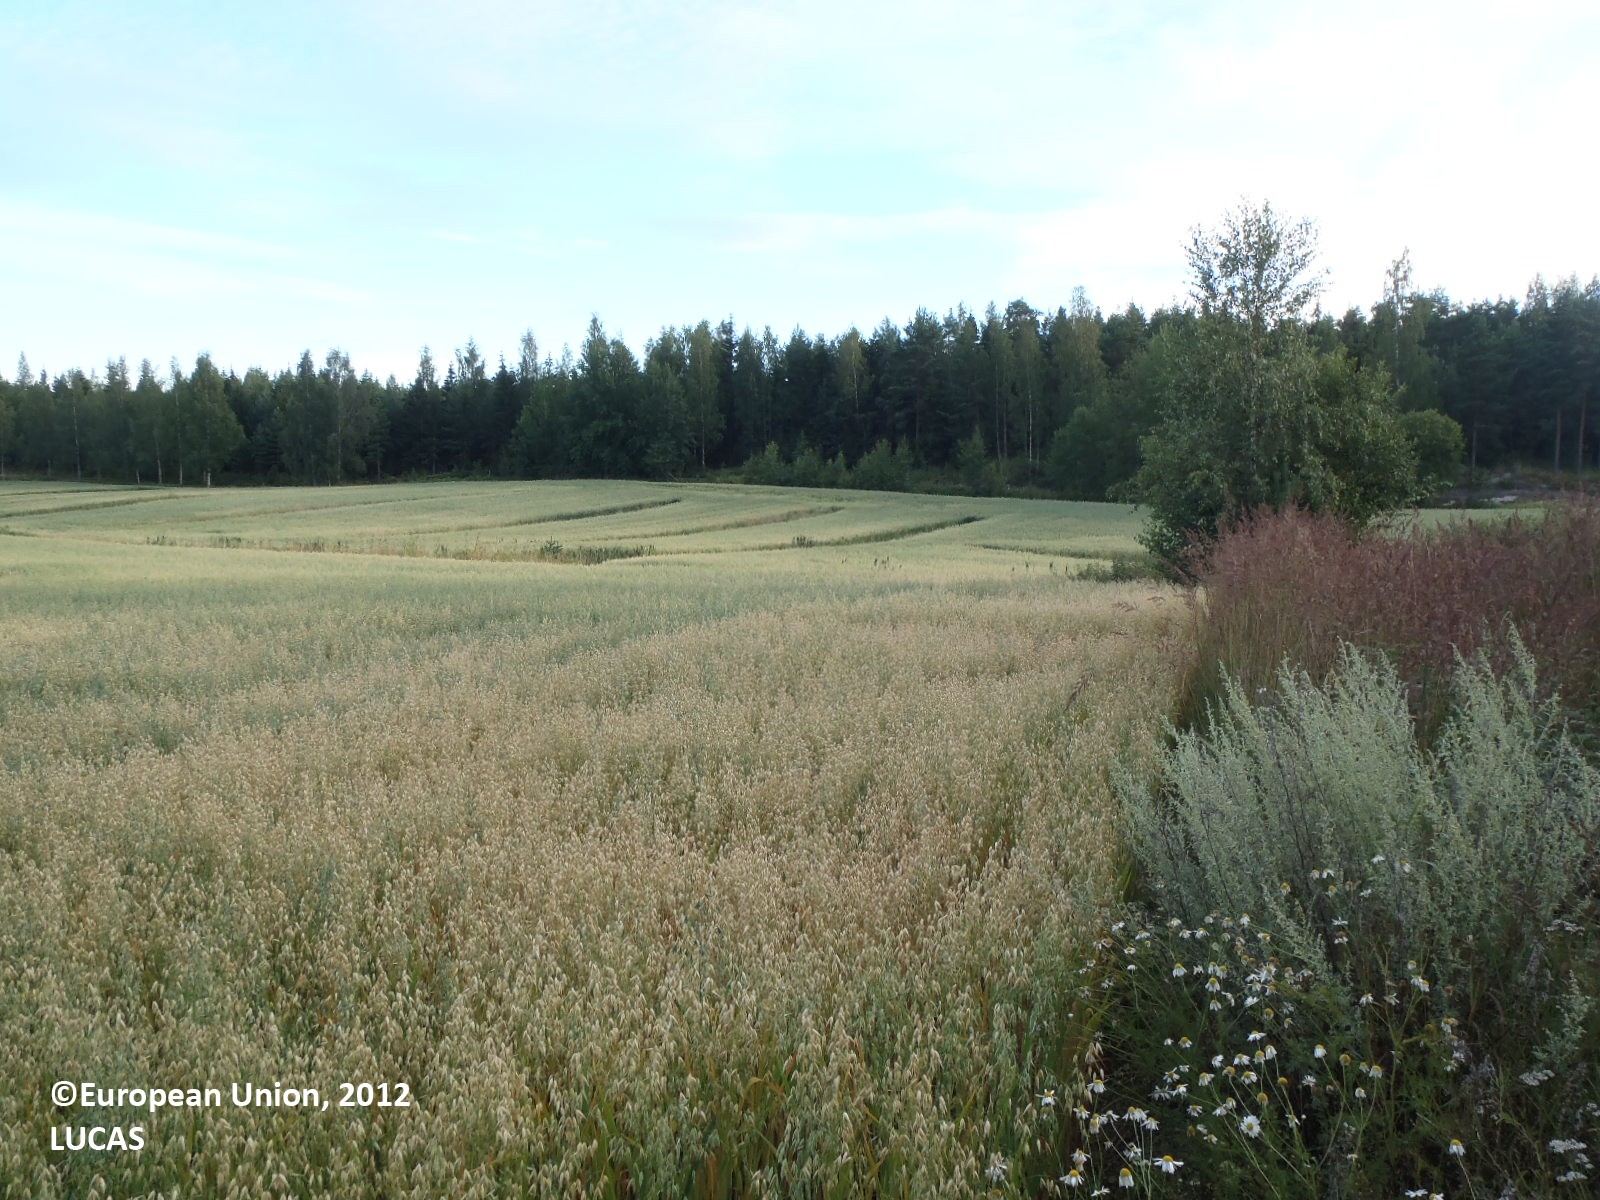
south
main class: Cropland
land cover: Oats
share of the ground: > 75 %
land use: Agriculture (excluding fallow land and kitchen gardens)
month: August
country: FI
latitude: 60.2133
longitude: 22.2131
